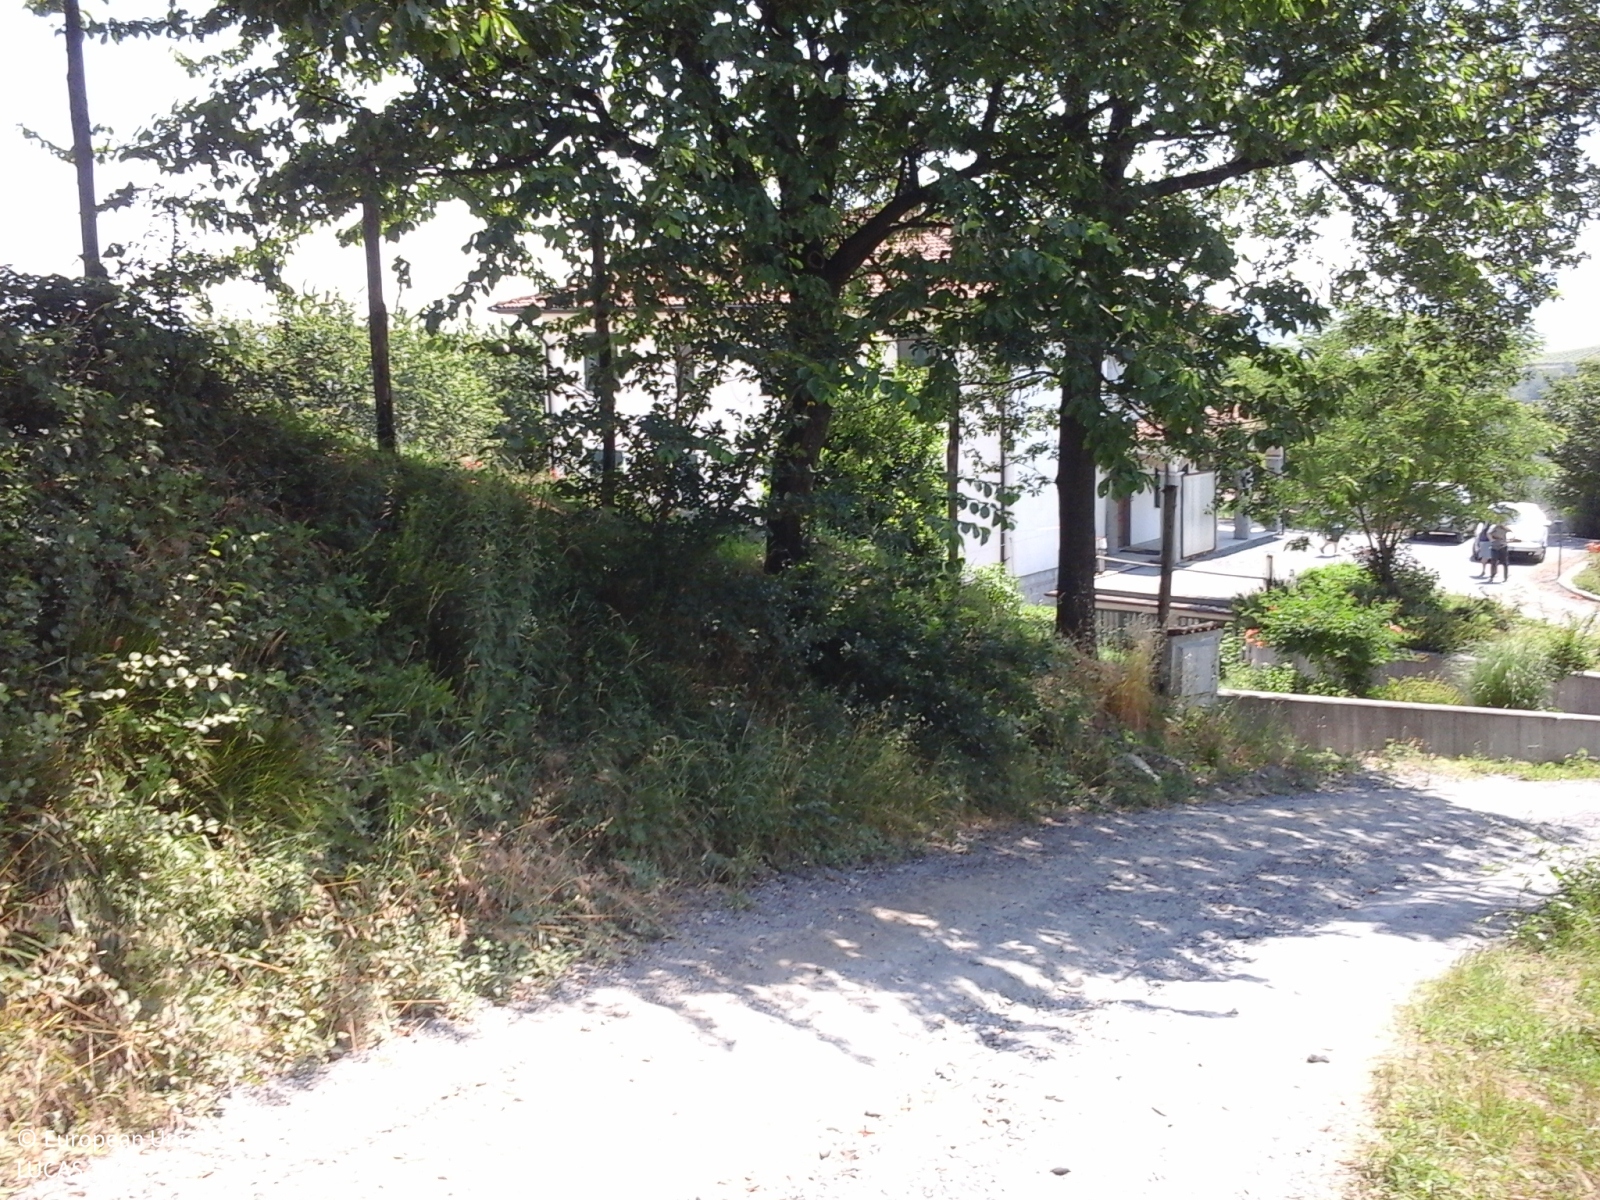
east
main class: Grassland
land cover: Grassland with sparse tree/shrub cover
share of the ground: > 75 %
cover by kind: herbaceous plants 95 %, broadleaved forest trees 5 %
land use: Agriculture (excluding fallow land and kitchen gardens)
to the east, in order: Grassland with sparse tree/shrub cover; Paved roads, cycling and walking lanes; Broadleaved woodland; Artificial constructions in urban areas; Grassland without tree/shrub cover; Ditches and canals; Grass margins; Paved roads, cycling and walking lanes; Grass margins; Ditches and canals; Fences; Electric lines; Vineyards
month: June
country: IT
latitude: 44.6683
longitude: 8.8042
